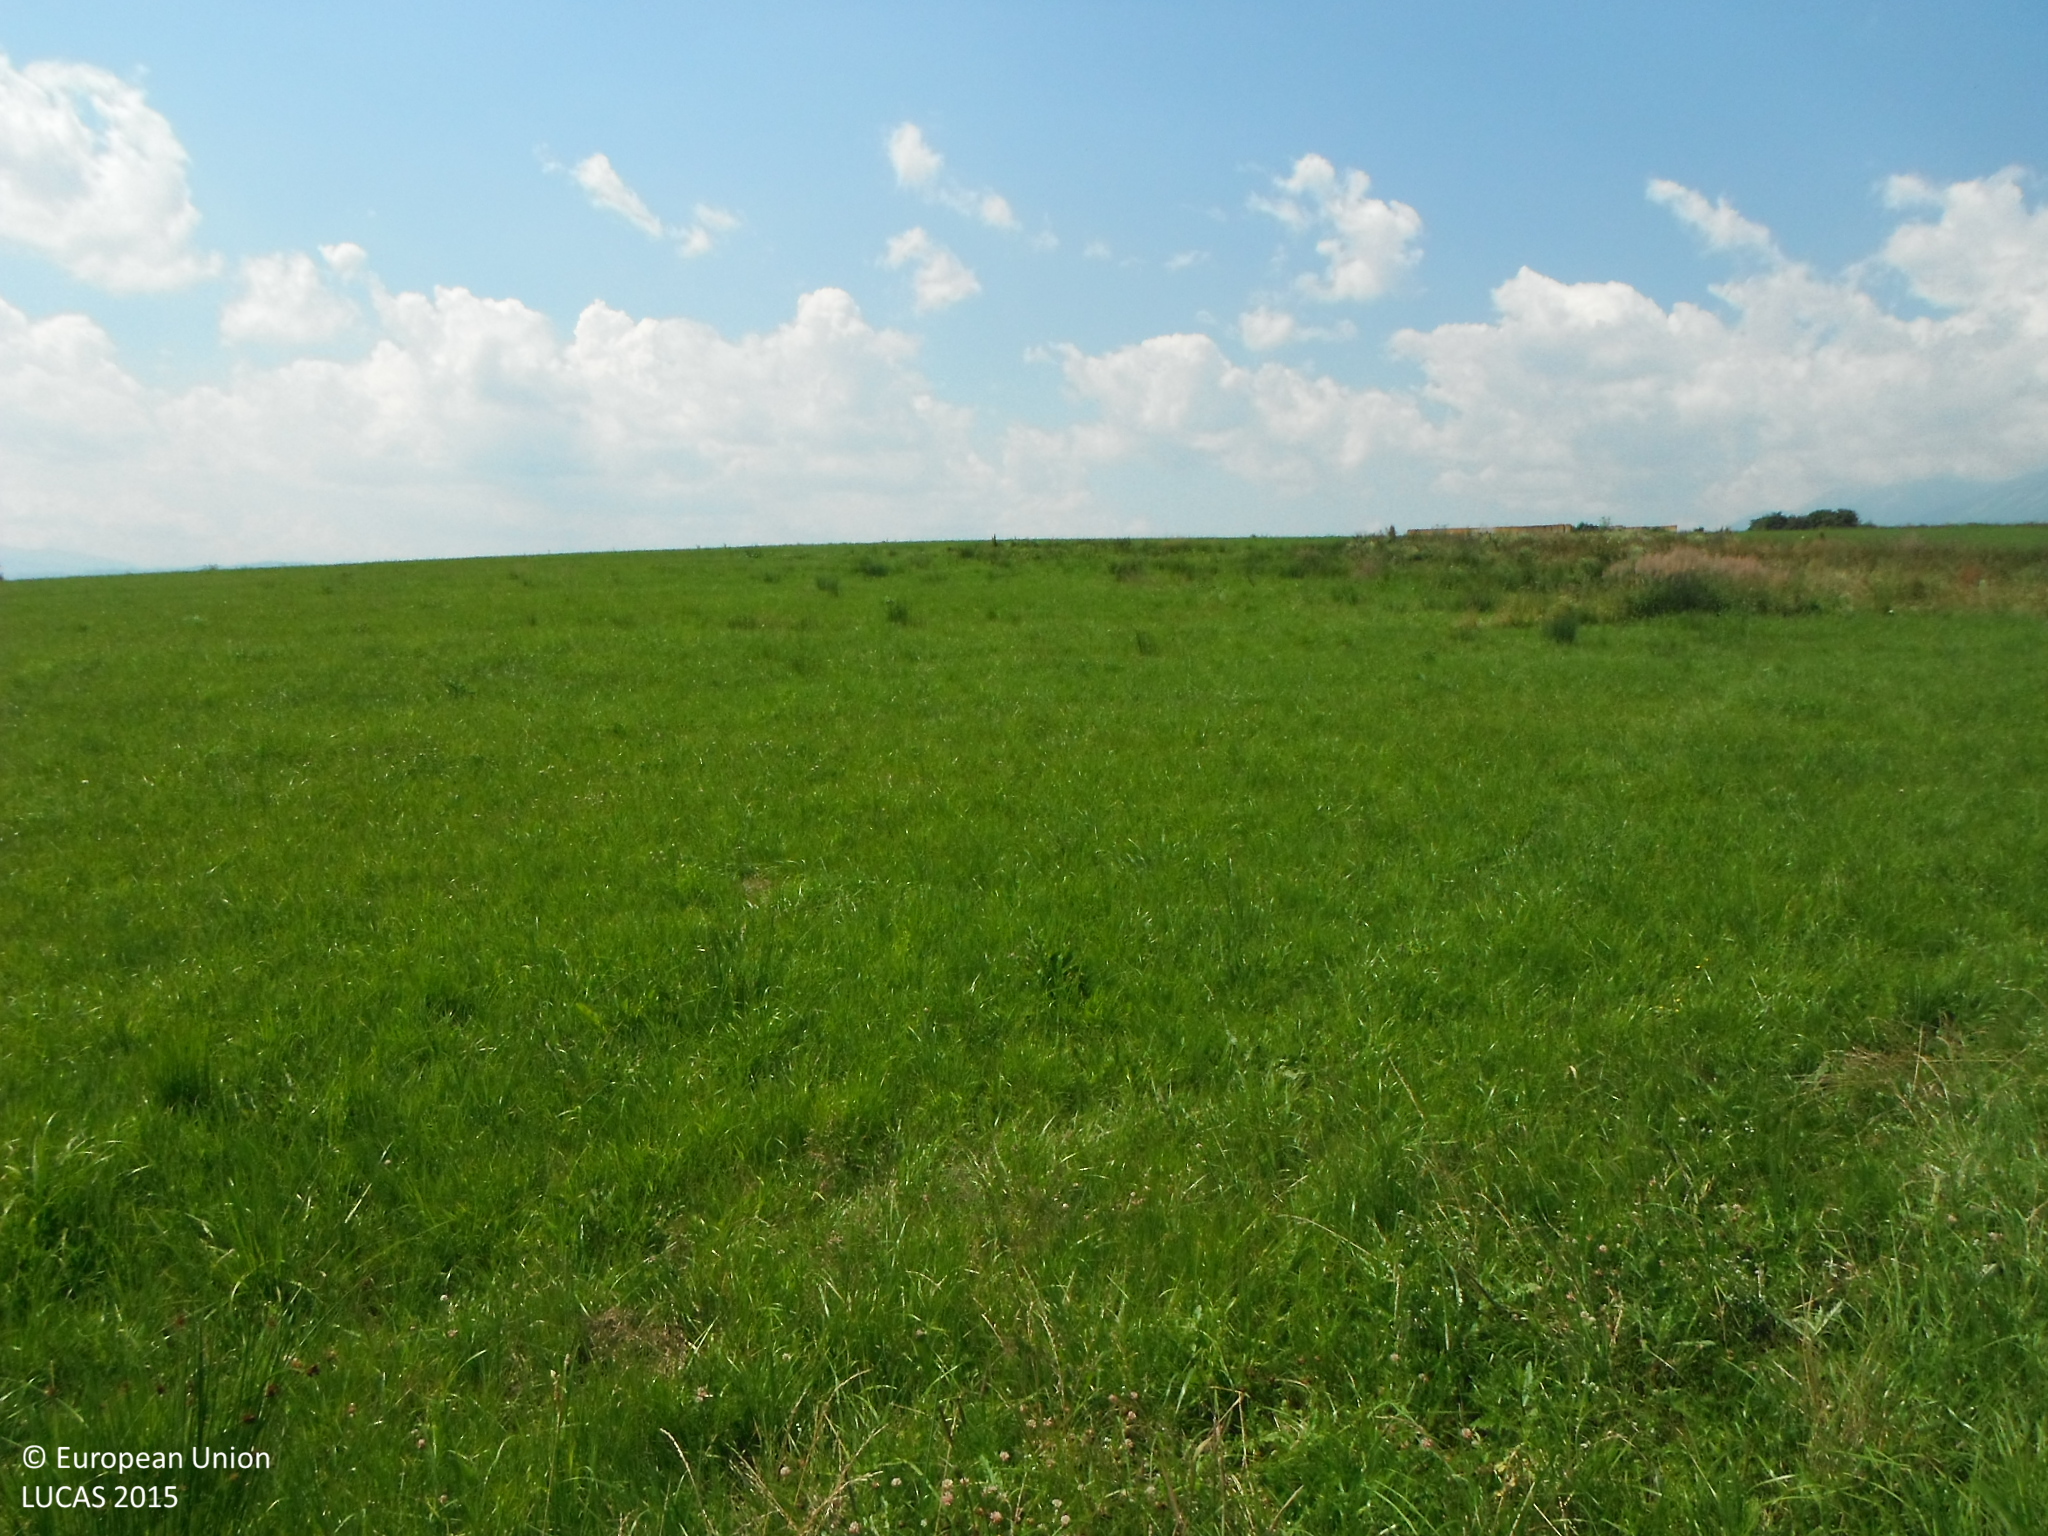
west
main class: Grassland
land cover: Grassland without tree/shrub cover
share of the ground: > 75 %
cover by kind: herbaceous plants 100 %
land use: Agriculture (excluding fallow land and kitchen gardens)
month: July
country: SK
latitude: 49.1287
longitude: 20.3817
